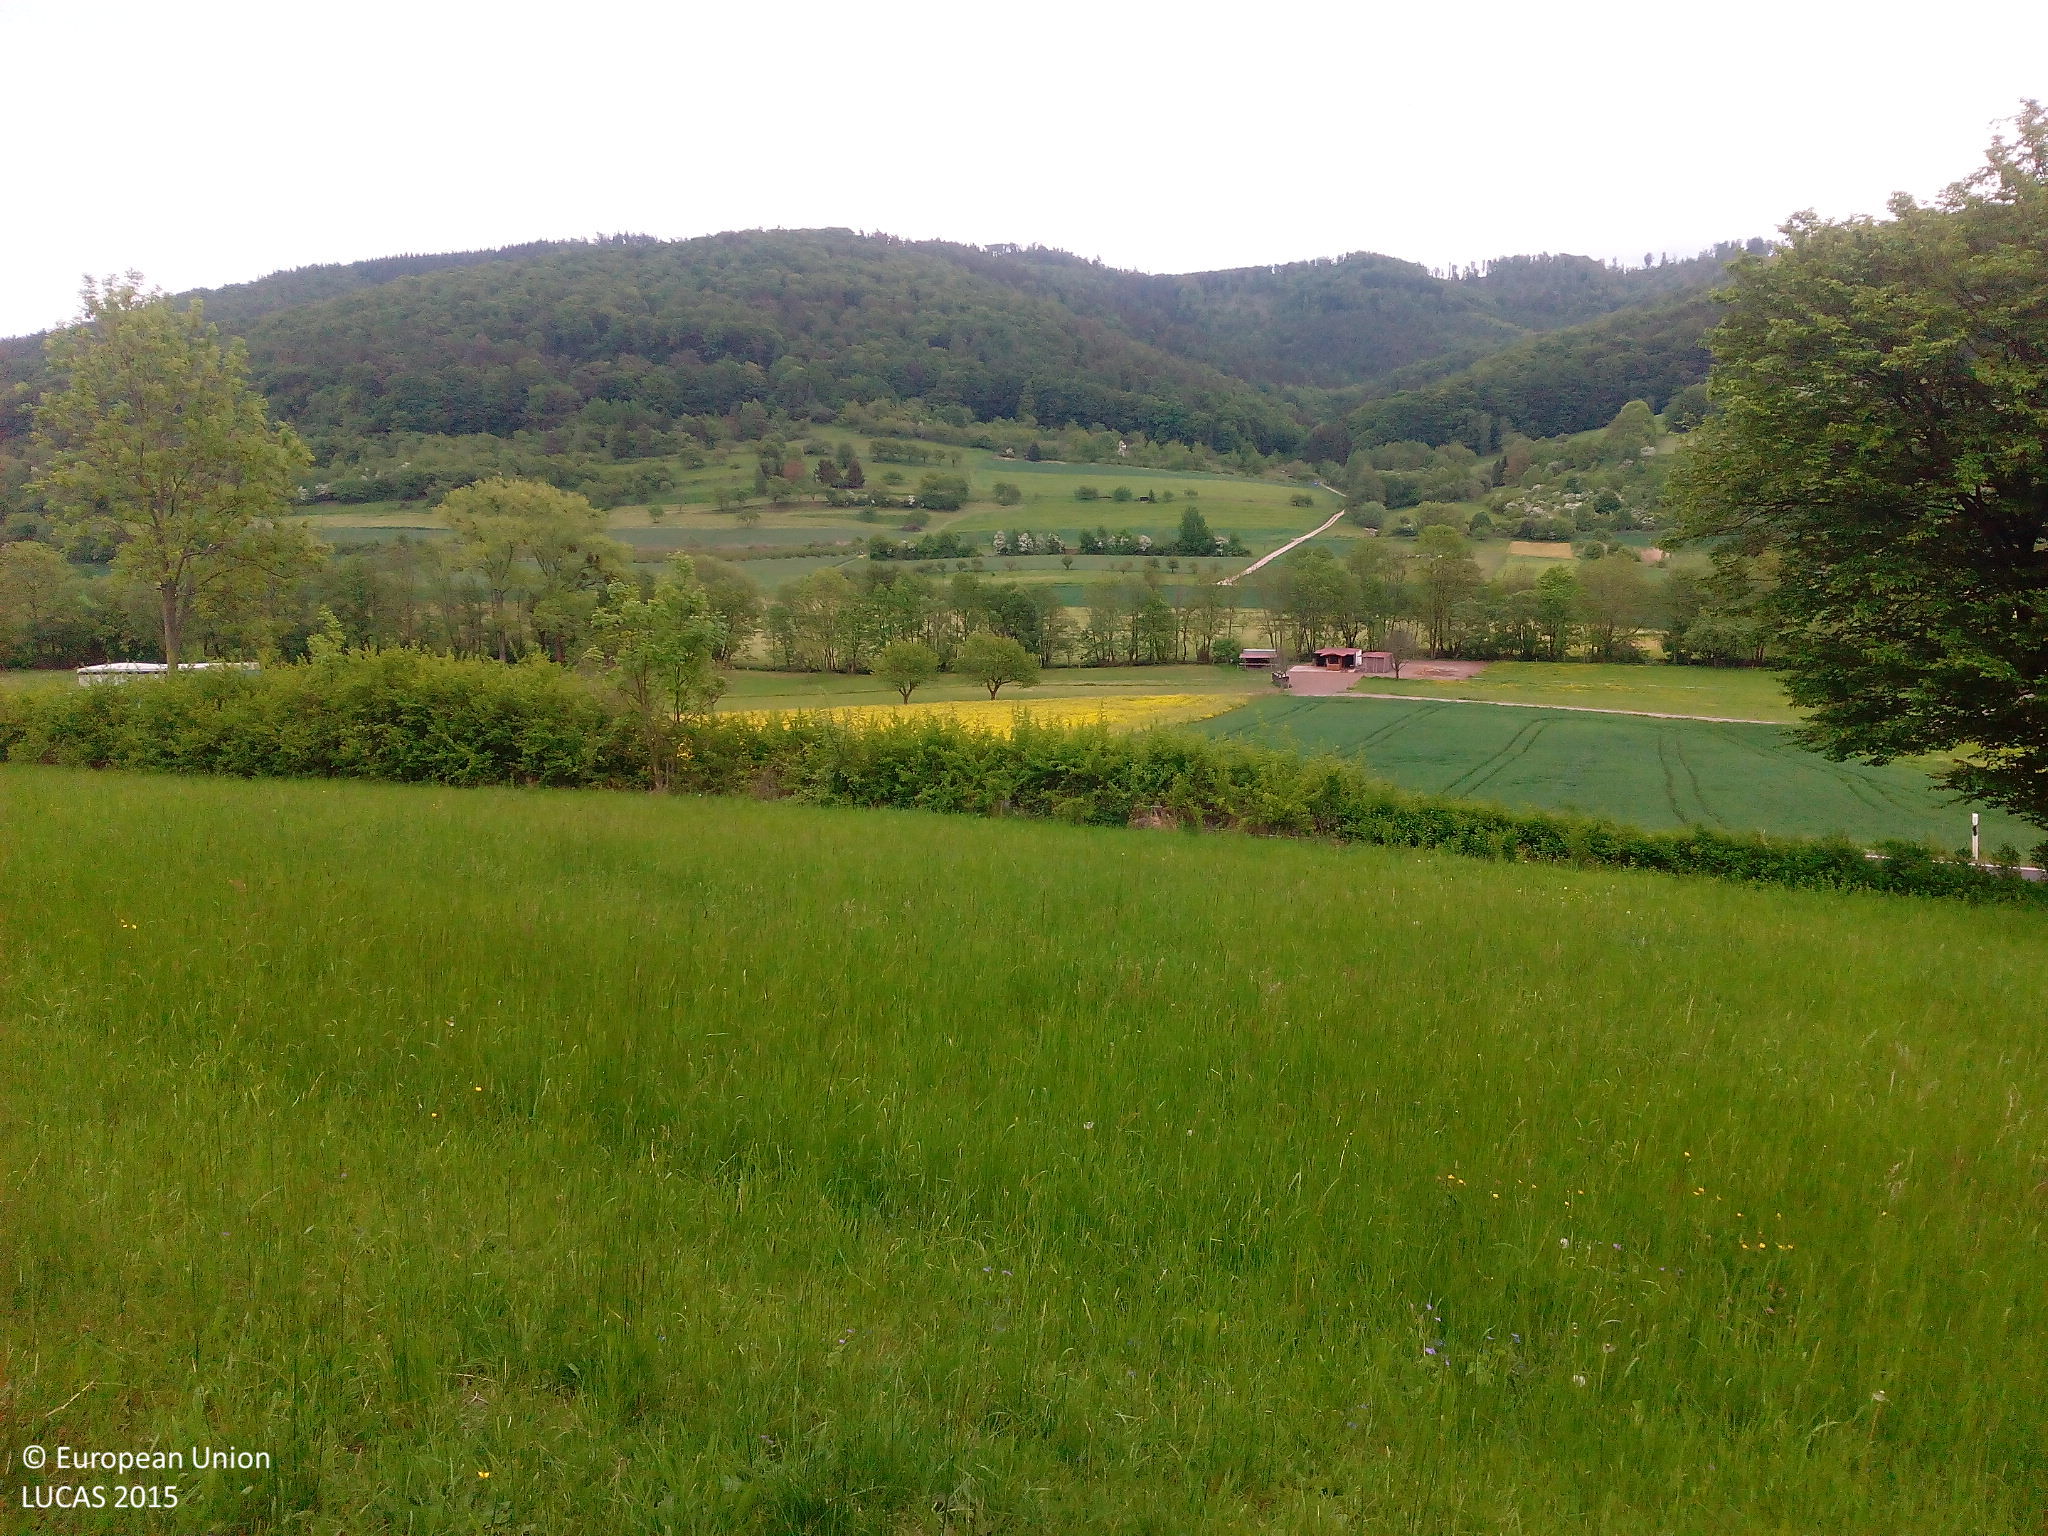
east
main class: Cropland
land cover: Cherry fruit
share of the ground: 25 - 50 %
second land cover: Grassland without tree/shrub cover
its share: > 75 %
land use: Agriculture (excluding fallow land and kitchen gardens)
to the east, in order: Cherry fruit; Grassland without tree/shrub cover; Managed hedges; Grass margins; Paved roads, cycling and walking lanes; Grass margins; Barley; Grass margins; Artificial constructions in urban areas
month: May
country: DE
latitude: 51.2809
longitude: 9.8423
